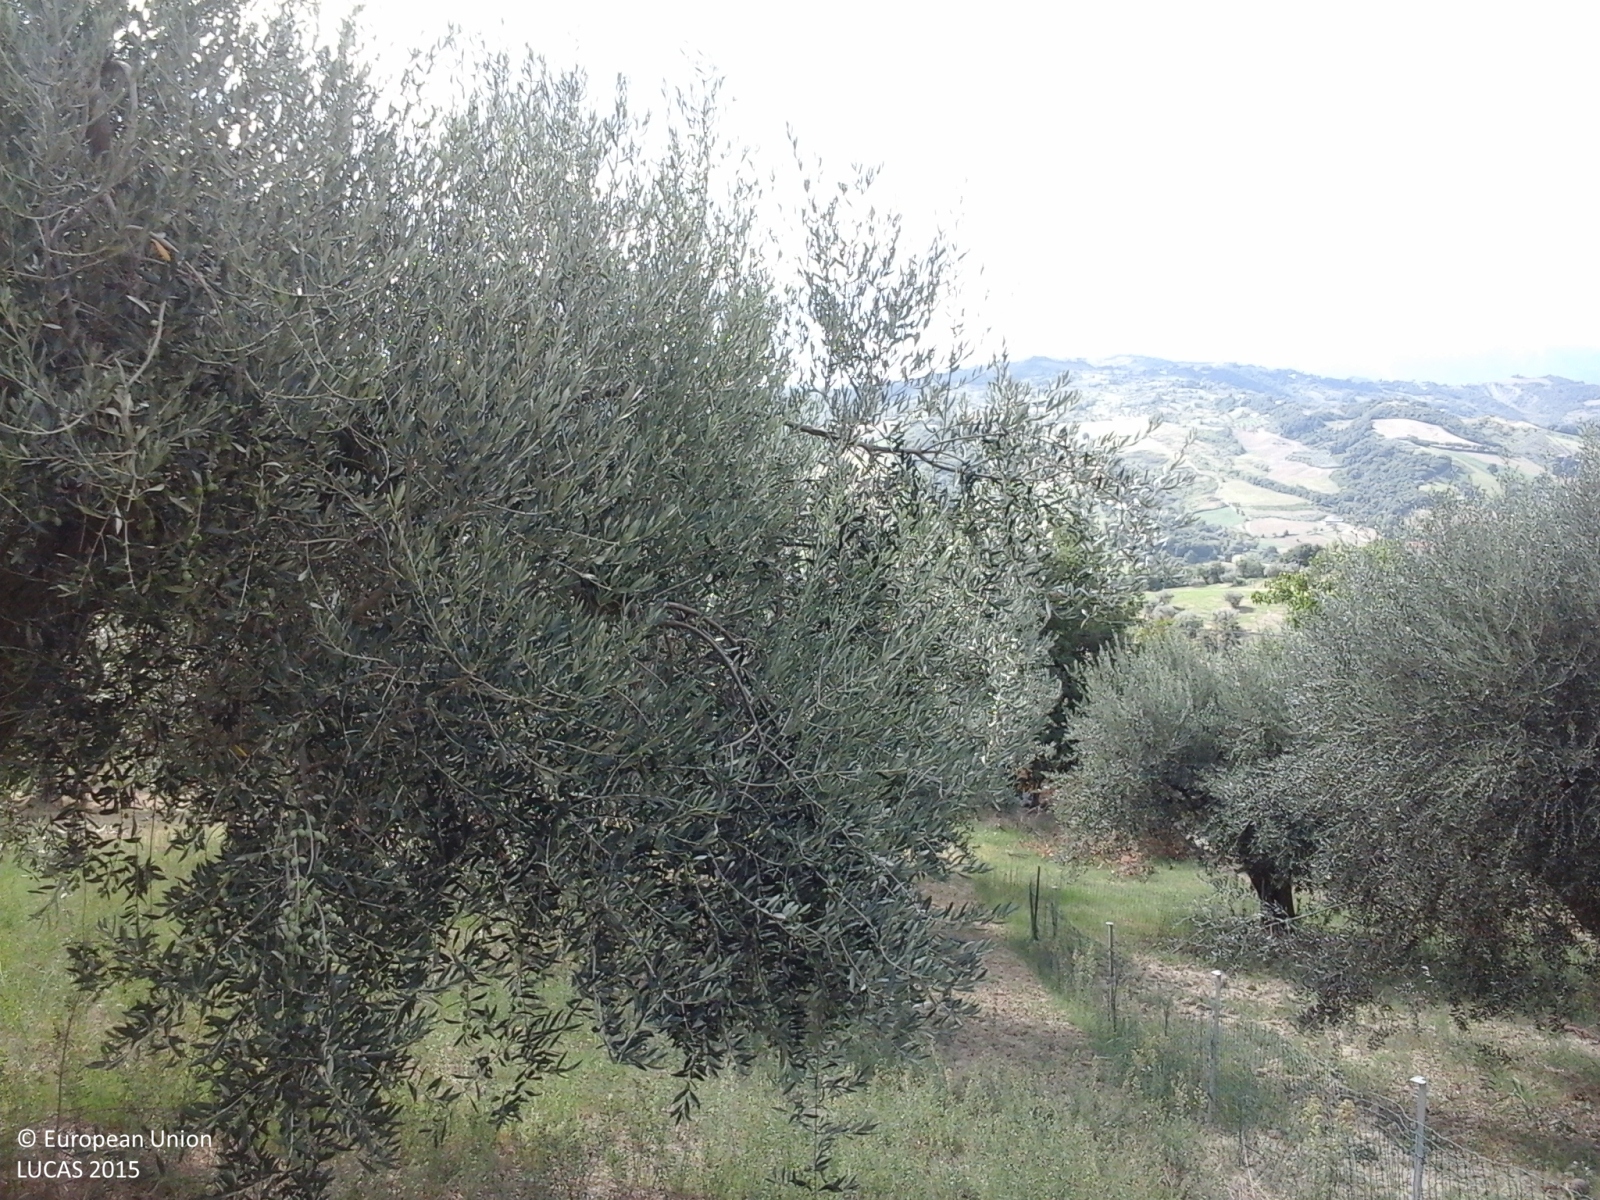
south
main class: Cropland
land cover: Olive groves
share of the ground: 10 - 25 %
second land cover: Tomatoes
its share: 50 - 75 %
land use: Agriculture (excluding fallow land and kitchen gardens)
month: September
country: IT
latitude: 42.6368
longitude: 13.8059
